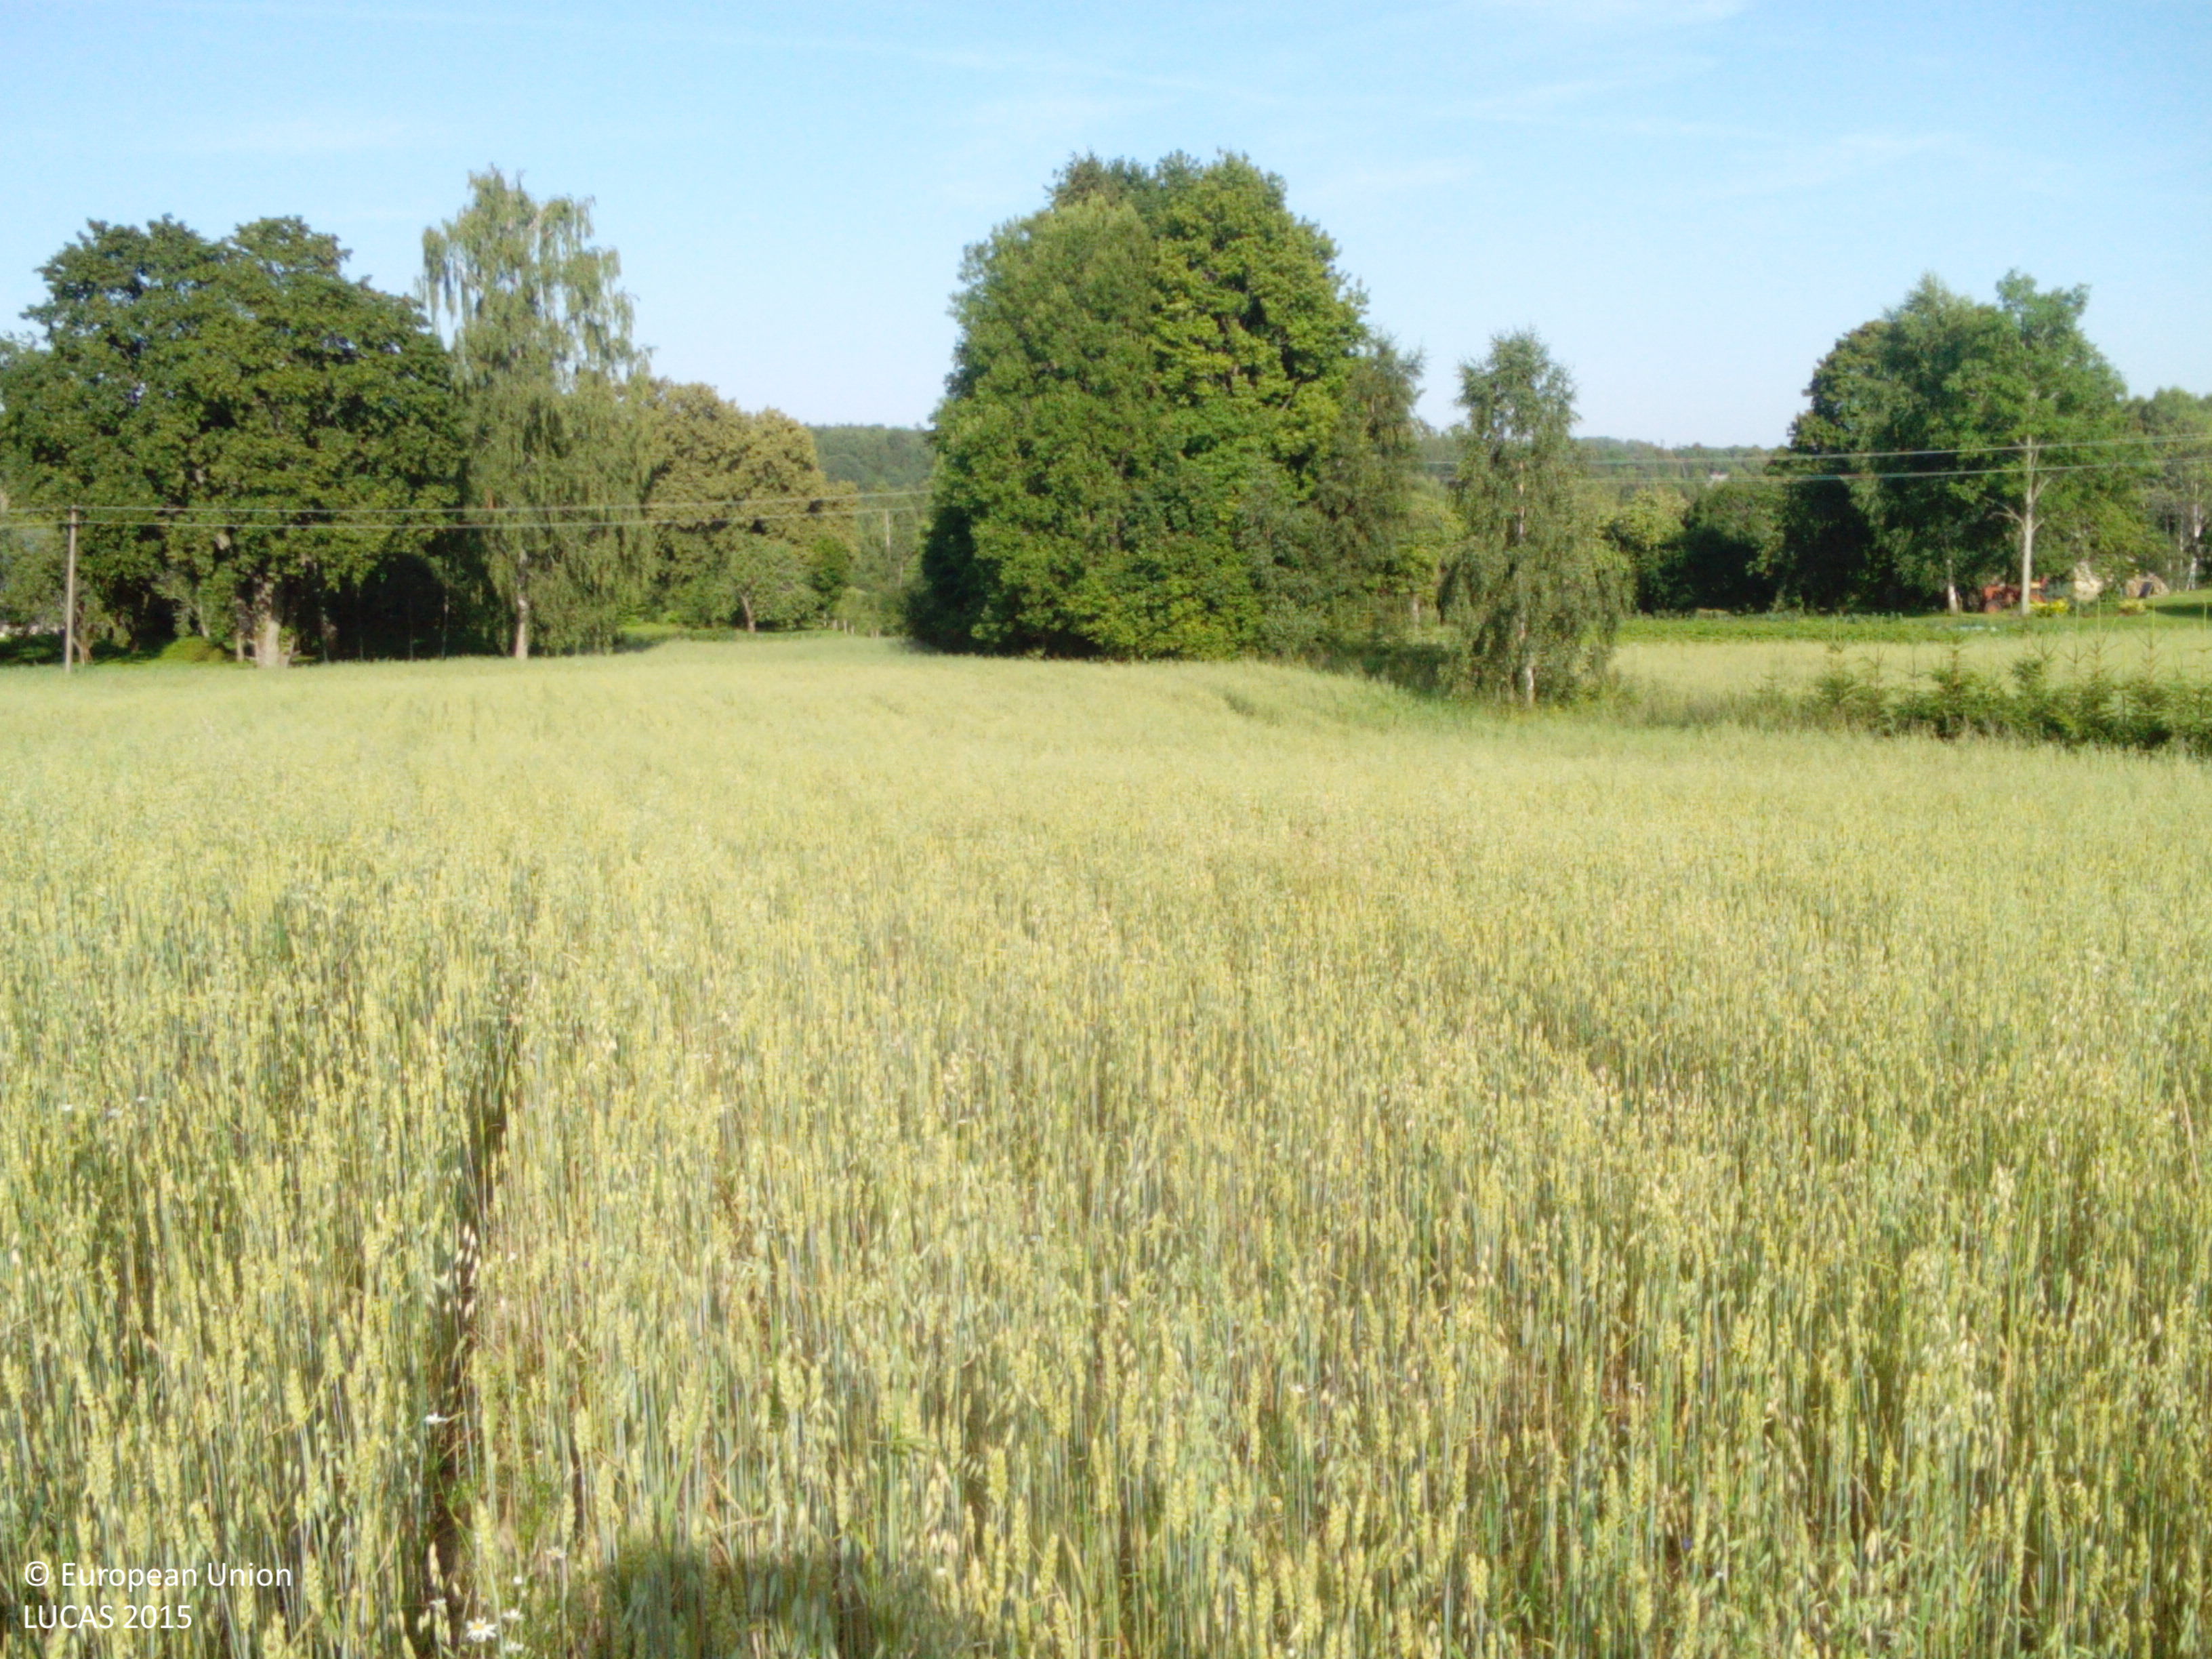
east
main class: Cropland
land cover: Common wheat
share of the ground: > 75 %
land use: Agriculture (excluding fallow land and kitchen gardens)
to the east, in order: Common wheat; Oats; Electric lines; Oats; Grassland without tree/shrub cover; Dry pulses; Grassland without tree/shrub cover; Apple fruit; Grassland without tree/shrub cover; Tracks; Grassland without tree/shrub cover
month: August
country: LV
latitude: 56.8568
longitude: 21.8369
